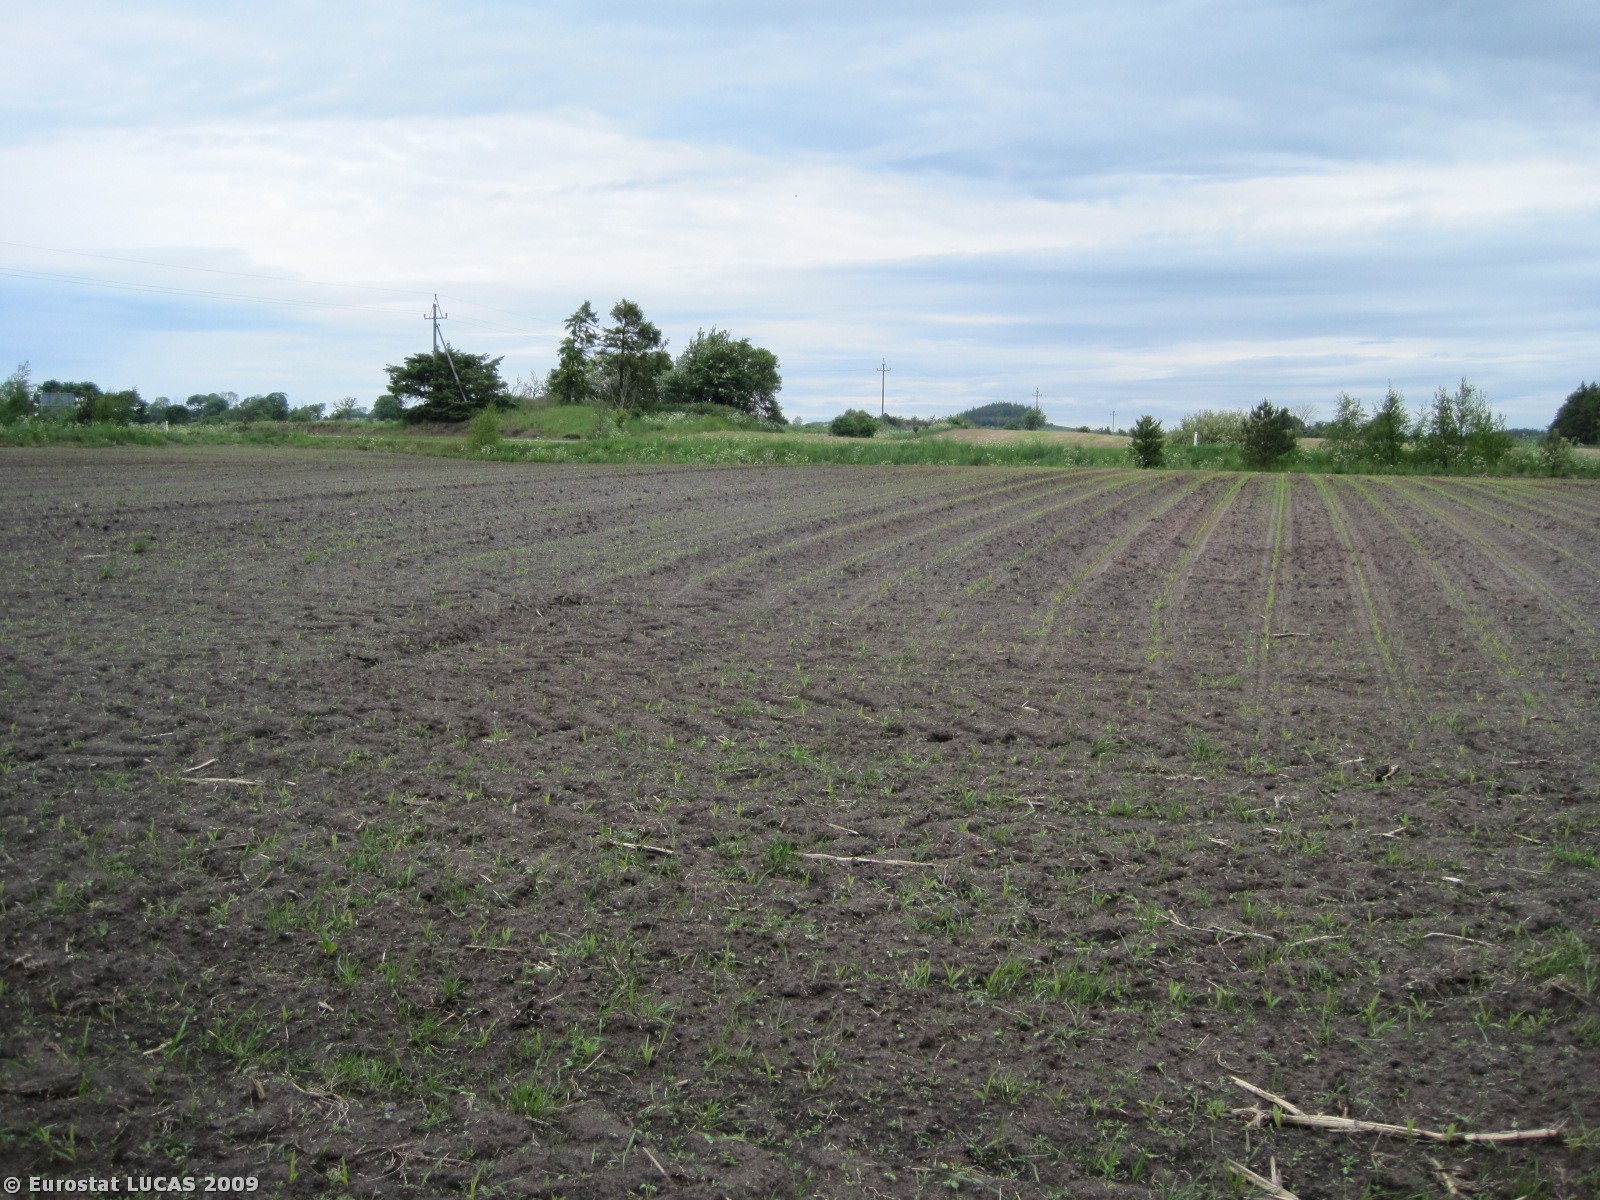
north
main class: Cropland
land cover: Maize
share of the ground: < 10 %
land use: Agriculture (excluding fallow land and kitchen gardens)
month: May
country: DK
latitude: 56.7270
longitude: 10.0490
